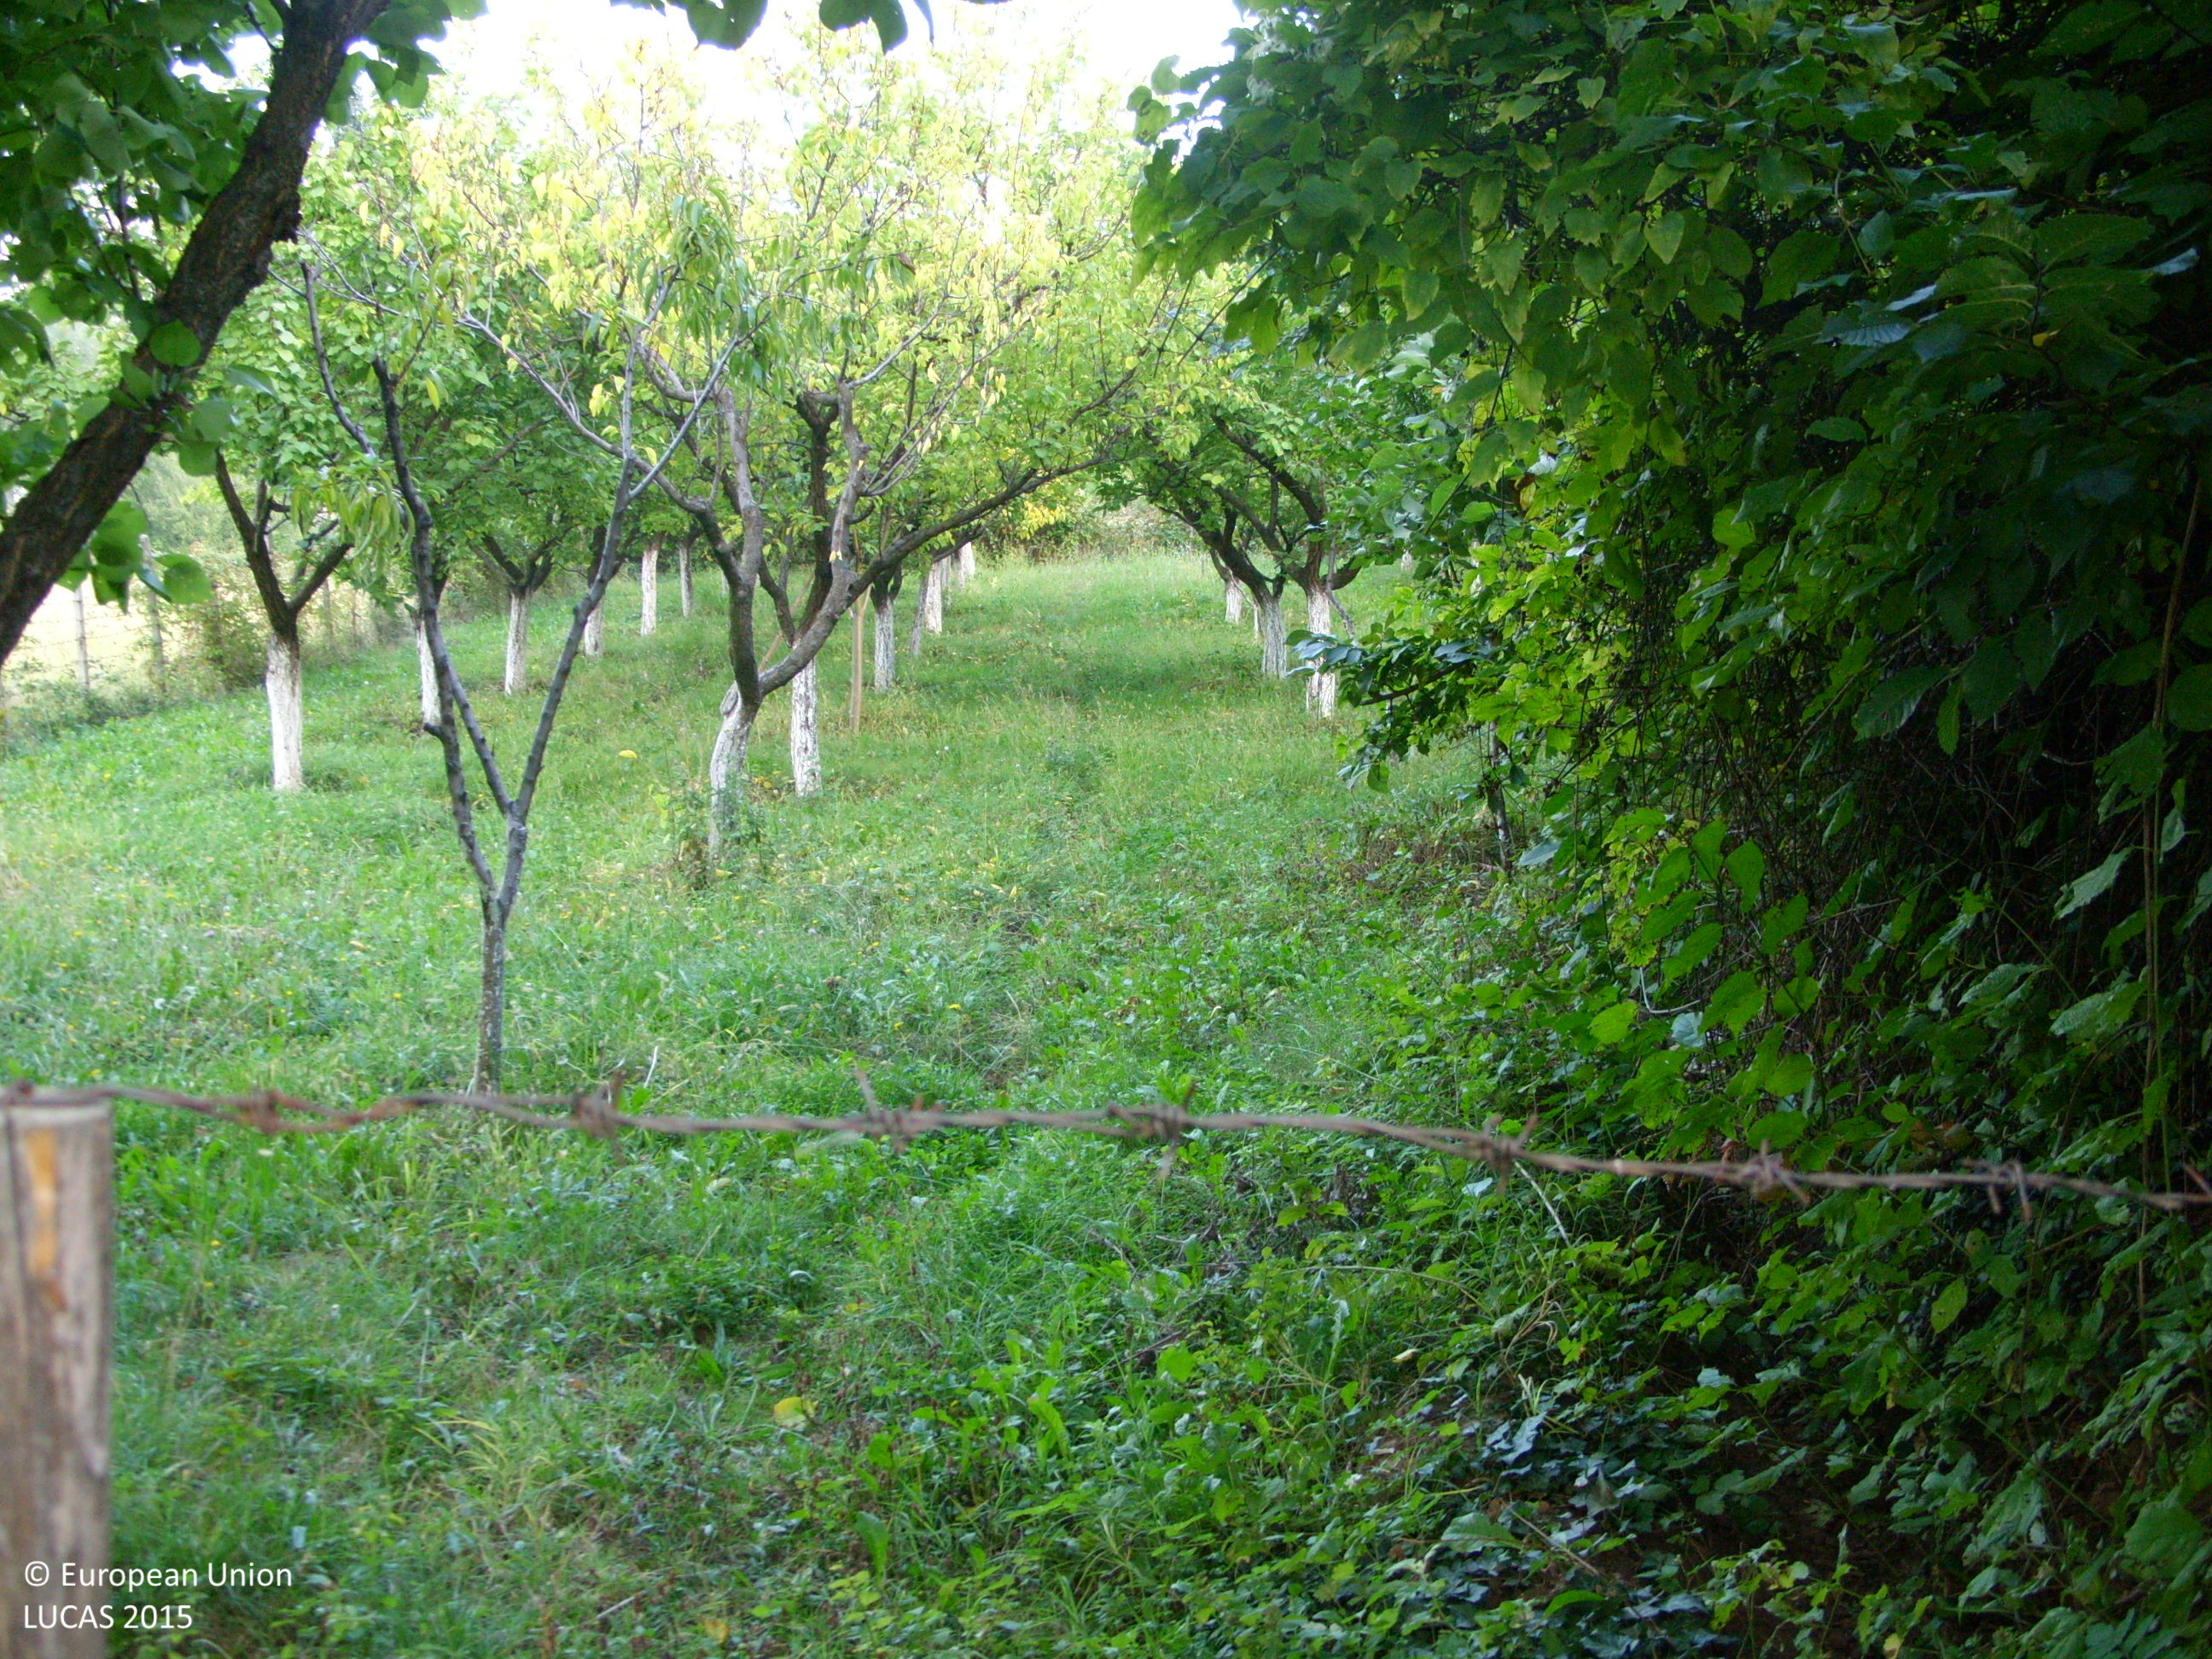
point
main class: Cropland
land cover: Other fruit trees and berries
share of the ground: 25 - 50 %
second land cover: Grassland without tree/shrub cover
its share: > 75 %
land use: Kitchen garden
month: October
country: BG
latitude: 42.1752
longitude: 24.0958
